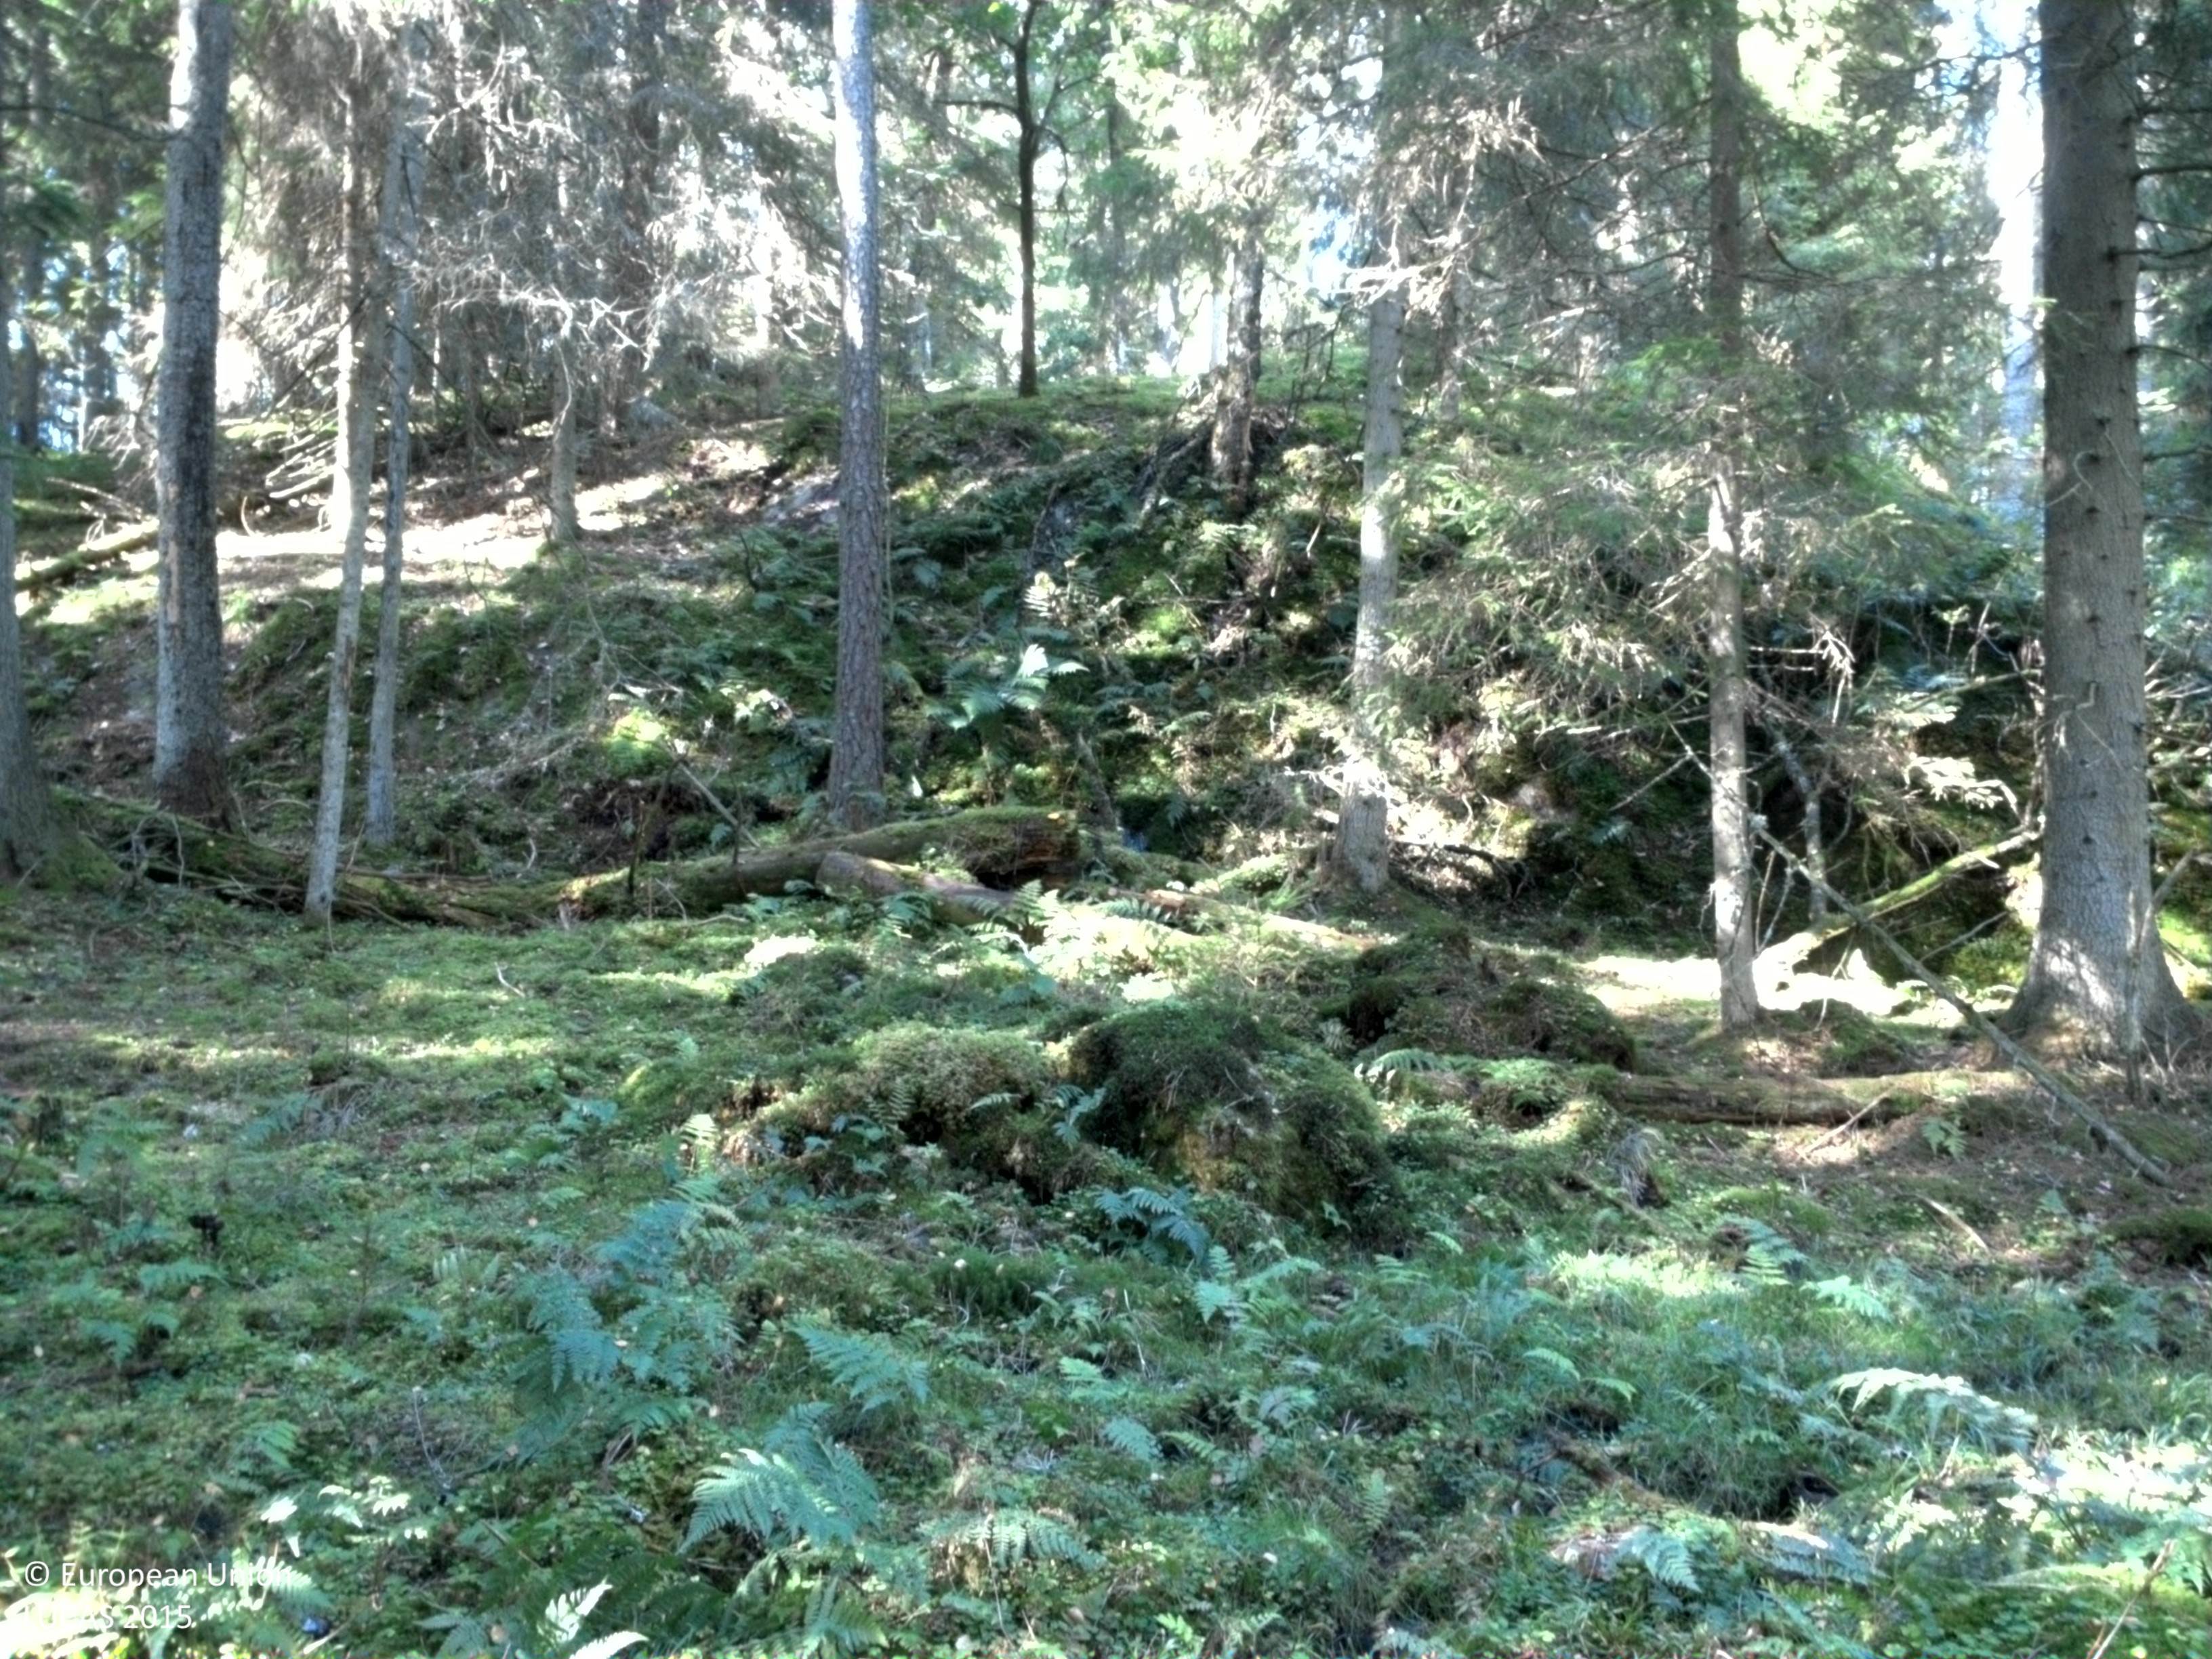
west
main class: Woodland
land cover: Spruce dominated mixed woodland
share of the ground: 50 - 75 %
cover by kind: coniferous forest trees 40 %, lichens and mosses 30 %, broadleaved forest trees 25 %, herbaceous plants 5 %
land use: Forestry
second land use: Agriculture (excluding fallow land and kitchen gardens)
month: September
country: SE
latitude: 57.9461
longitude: 13.2555
